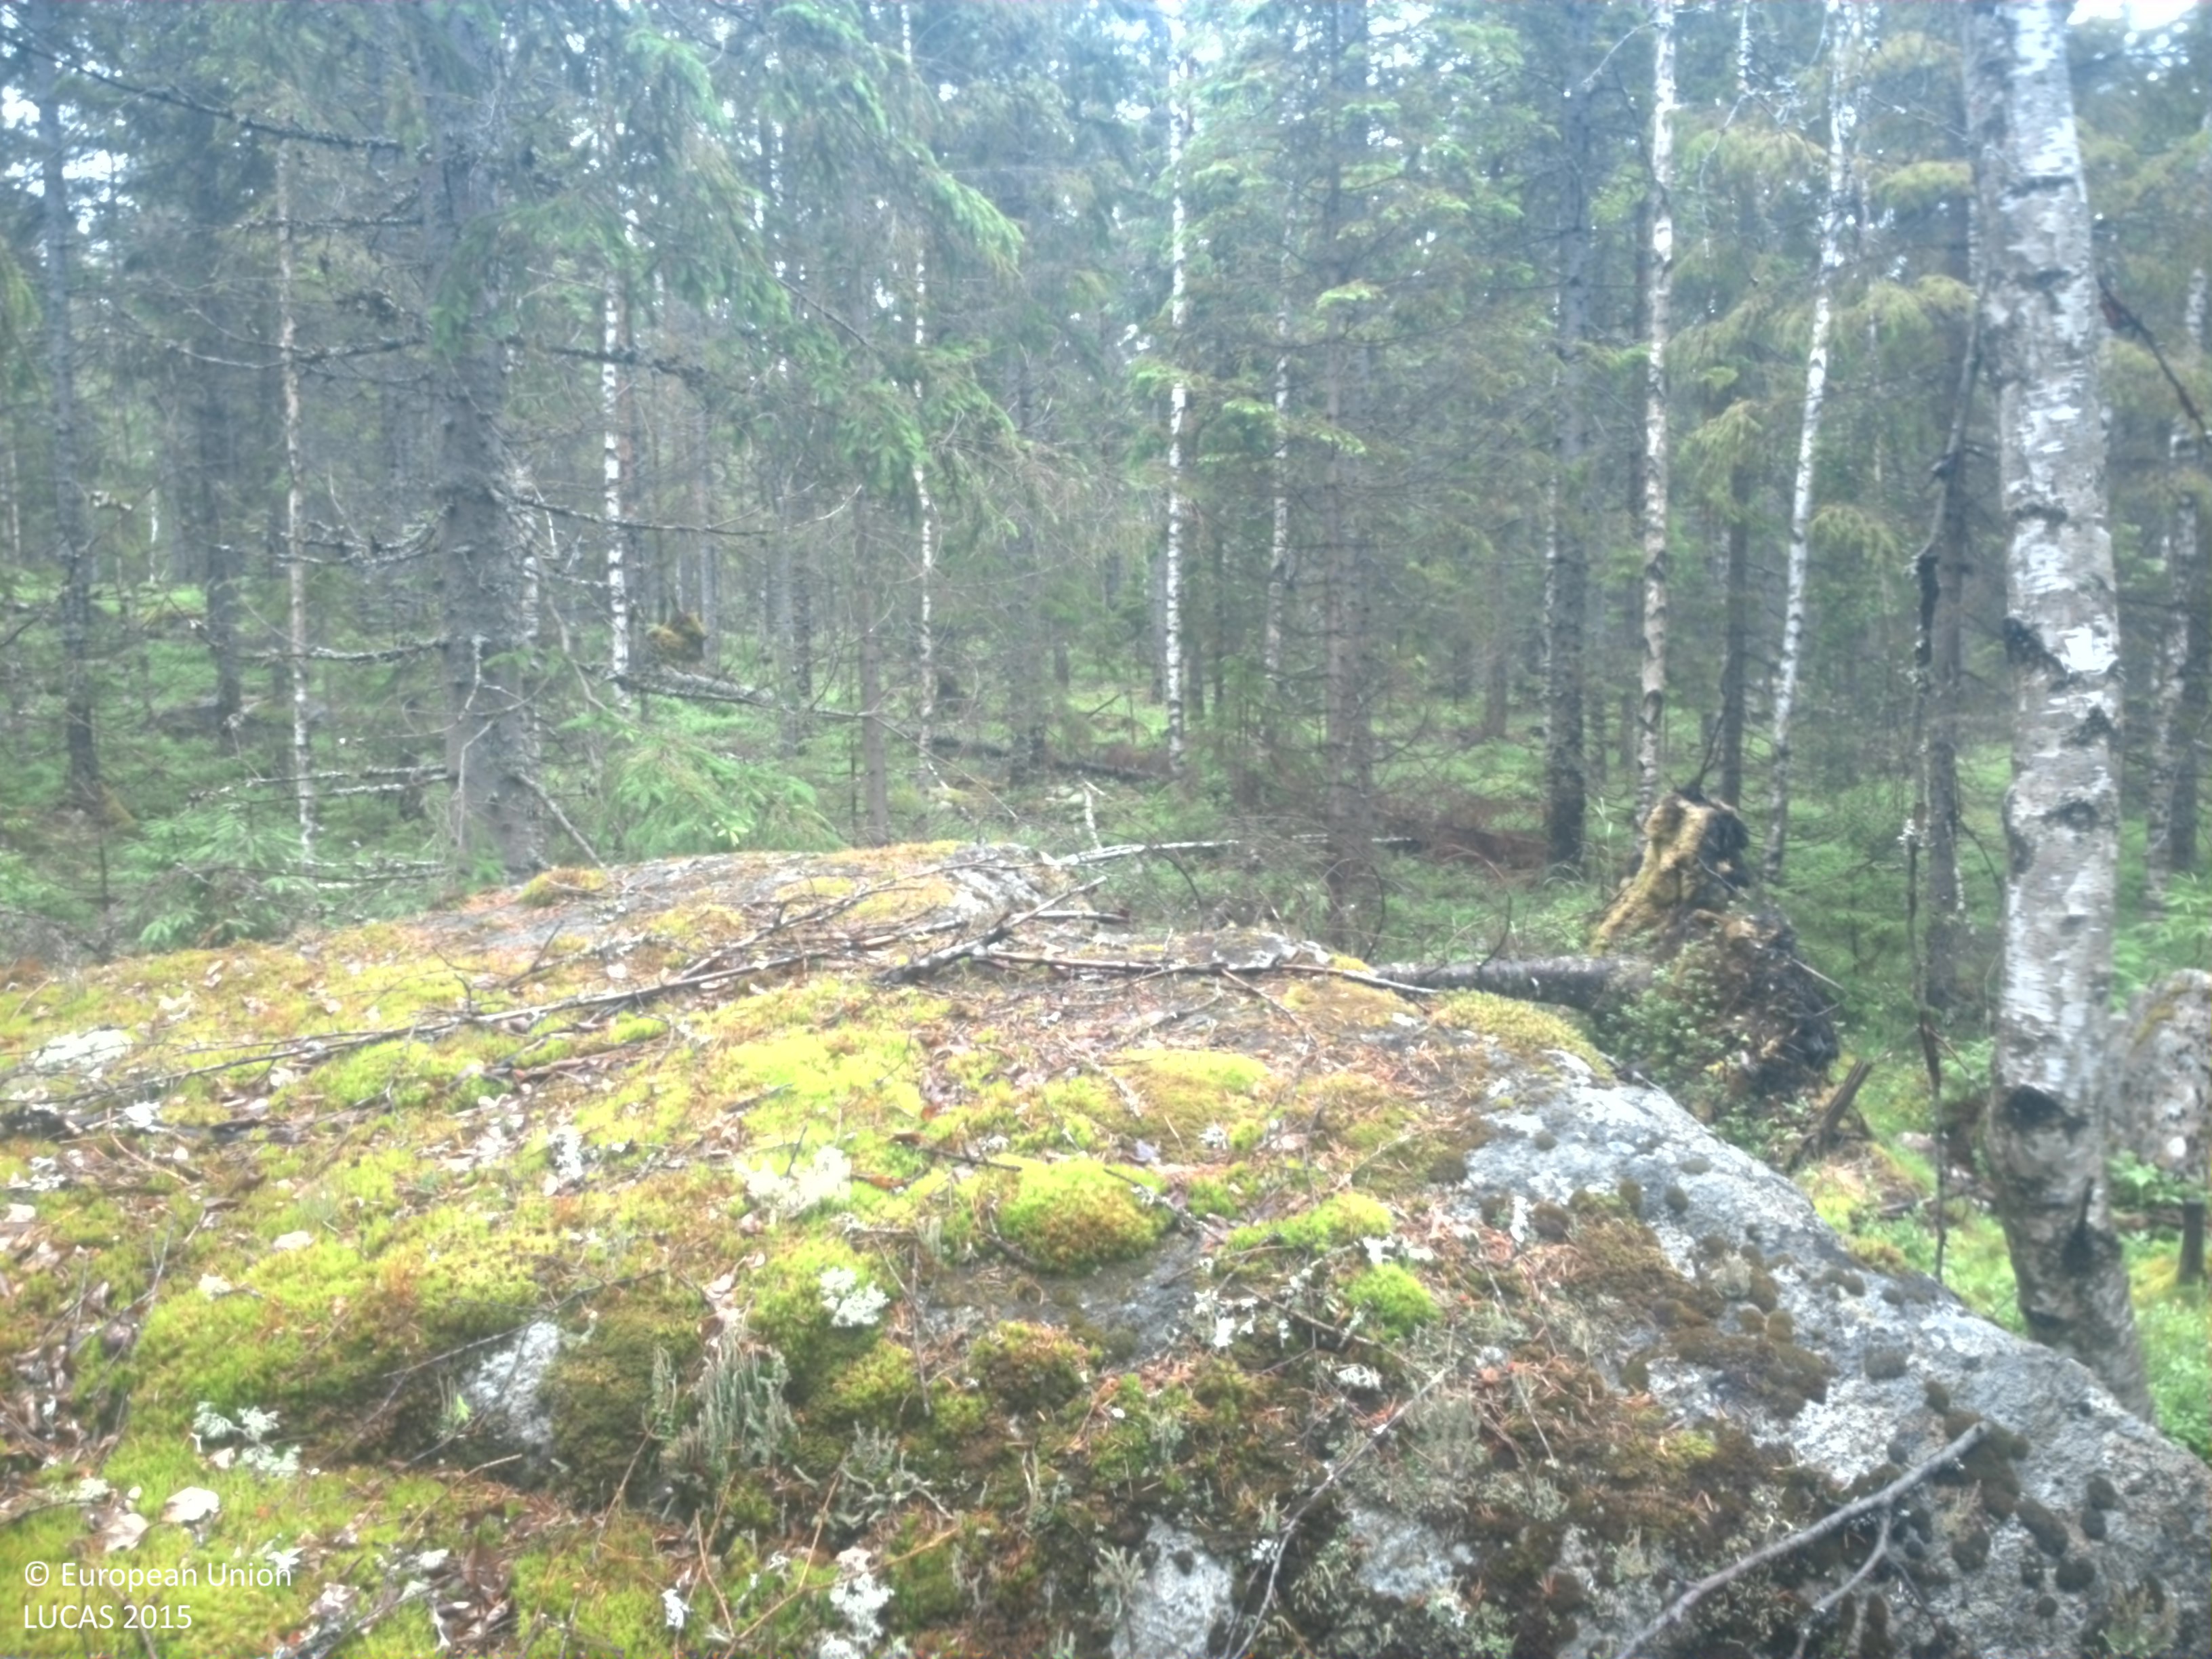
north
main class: Woodland
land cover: Spruce dominated mixed woodland
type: boreal forest
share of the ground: 50 - 75 %
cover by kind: coniferous forest trees 40 %, broadleaved forest trees 20 %, shrubs 20 %, herbaceous plants 10 %, lichens and mosses 5 %, consolidated bare surface 5 %
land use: Forestry
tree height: > 5 m
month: July
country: SE
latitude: 59.5870
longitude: 14.4713
